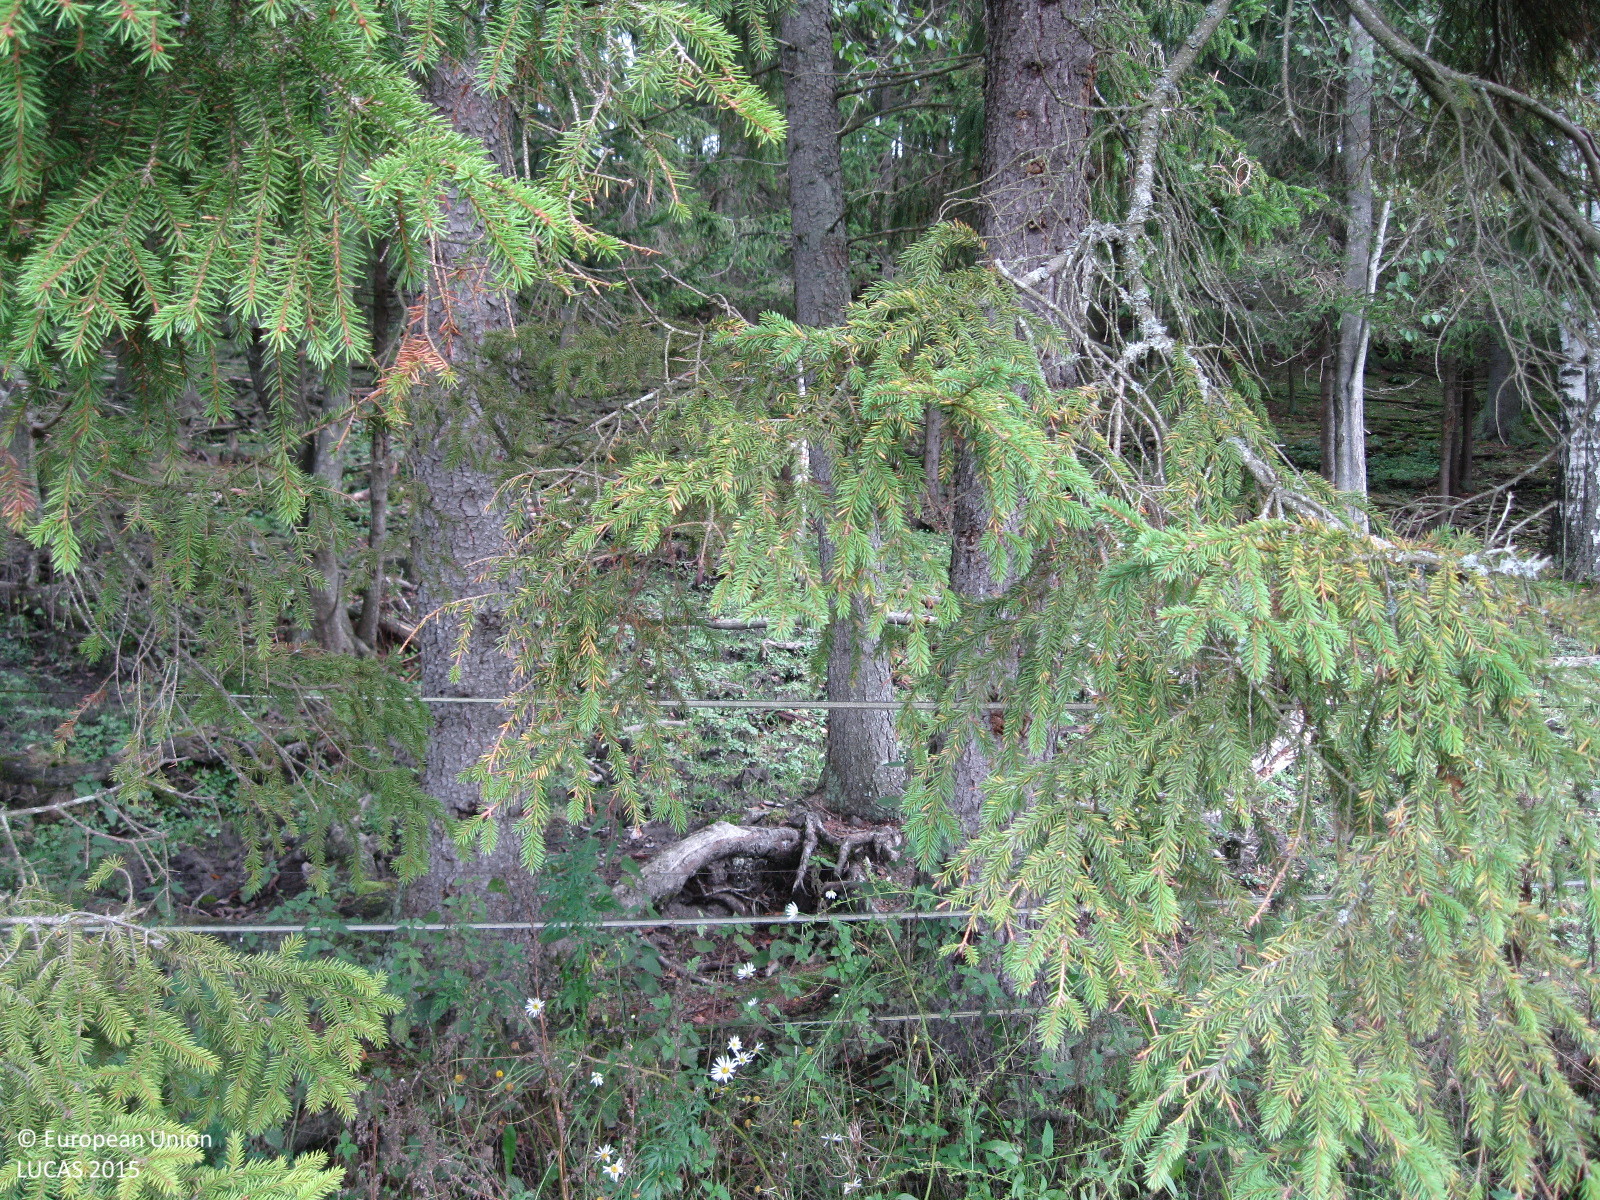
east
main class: Cropland
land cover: Common wheat
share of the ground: > 75 %
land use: Agriculture (excluding fallow land and kitchen gardens)
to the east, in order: Common wheat; Grass margins; Ditches and canals; Fences; Spruce dominated coniferous woodland; Grassland without tree/shrub cover; Electric lines; Grassland without tree/shrub cover; Fences; Spontaneously vegetated surfaces; Paved roads, cycling and walking lanes; Grass margins; Fences; Other bare soil; Electric lines; Other bare soil; Grassland without tree/shrub cover
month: September
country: FI
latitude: 60.4171
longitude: 24.1364
